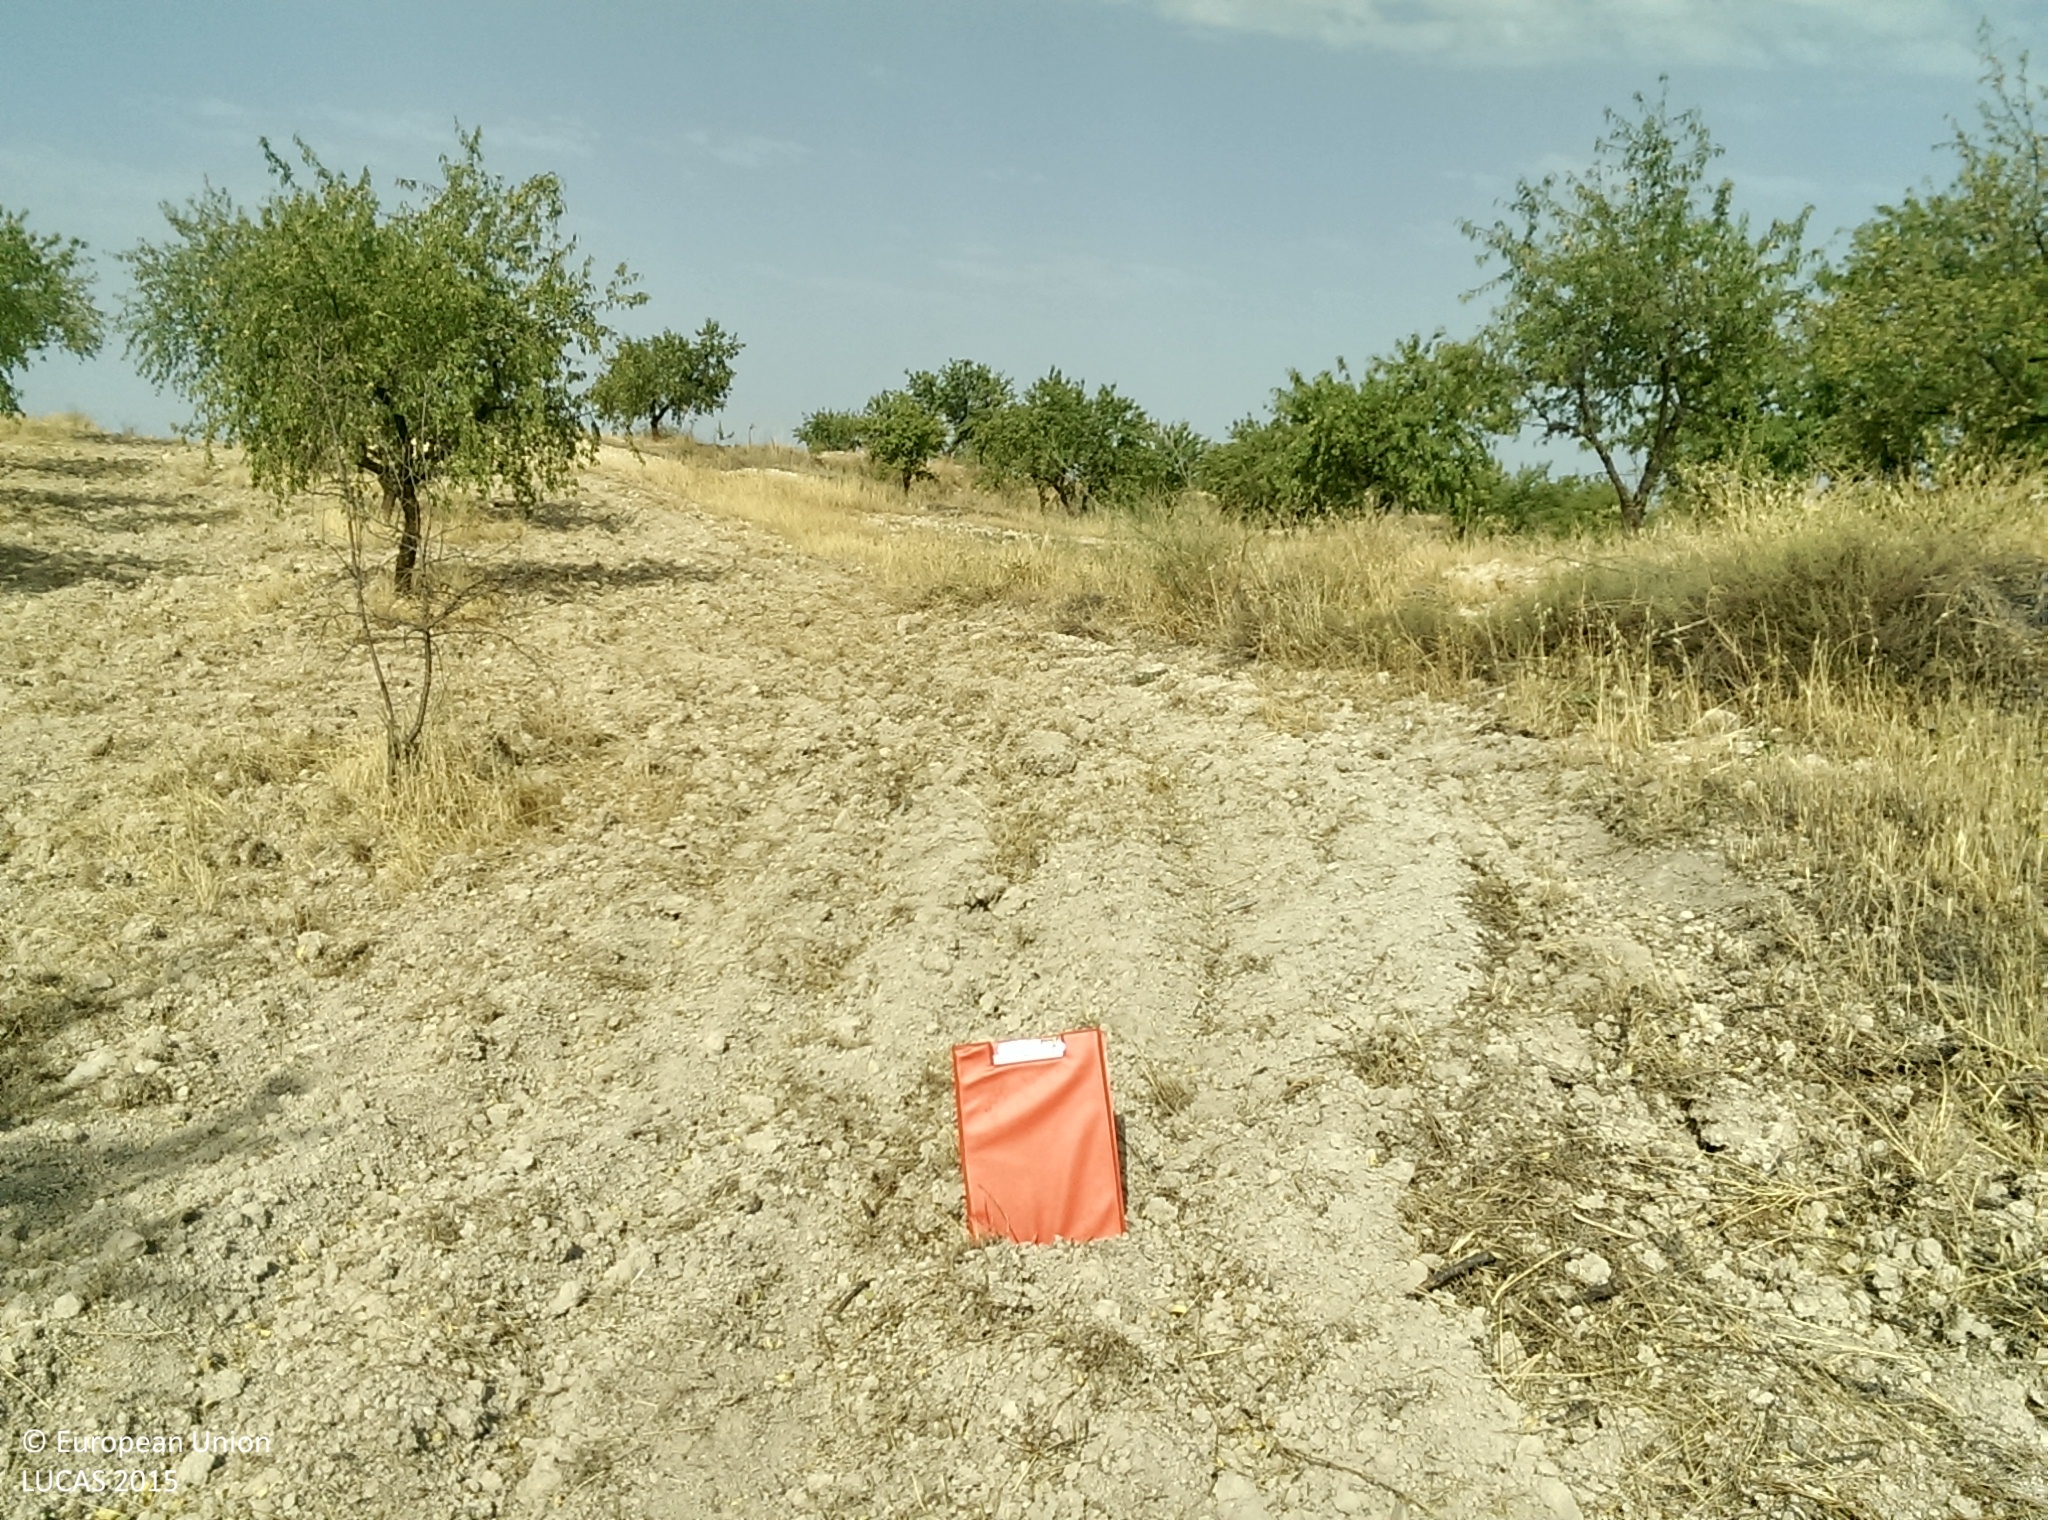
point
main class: Cropland
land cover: Nuts trees
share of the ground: 25 - 50 %
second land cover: Other bare soil
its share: > 75 %
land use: Agriculture (excluding fallow land and kitchen gardens)
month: July
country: ES
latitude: 37.5998
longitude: -2.8906
